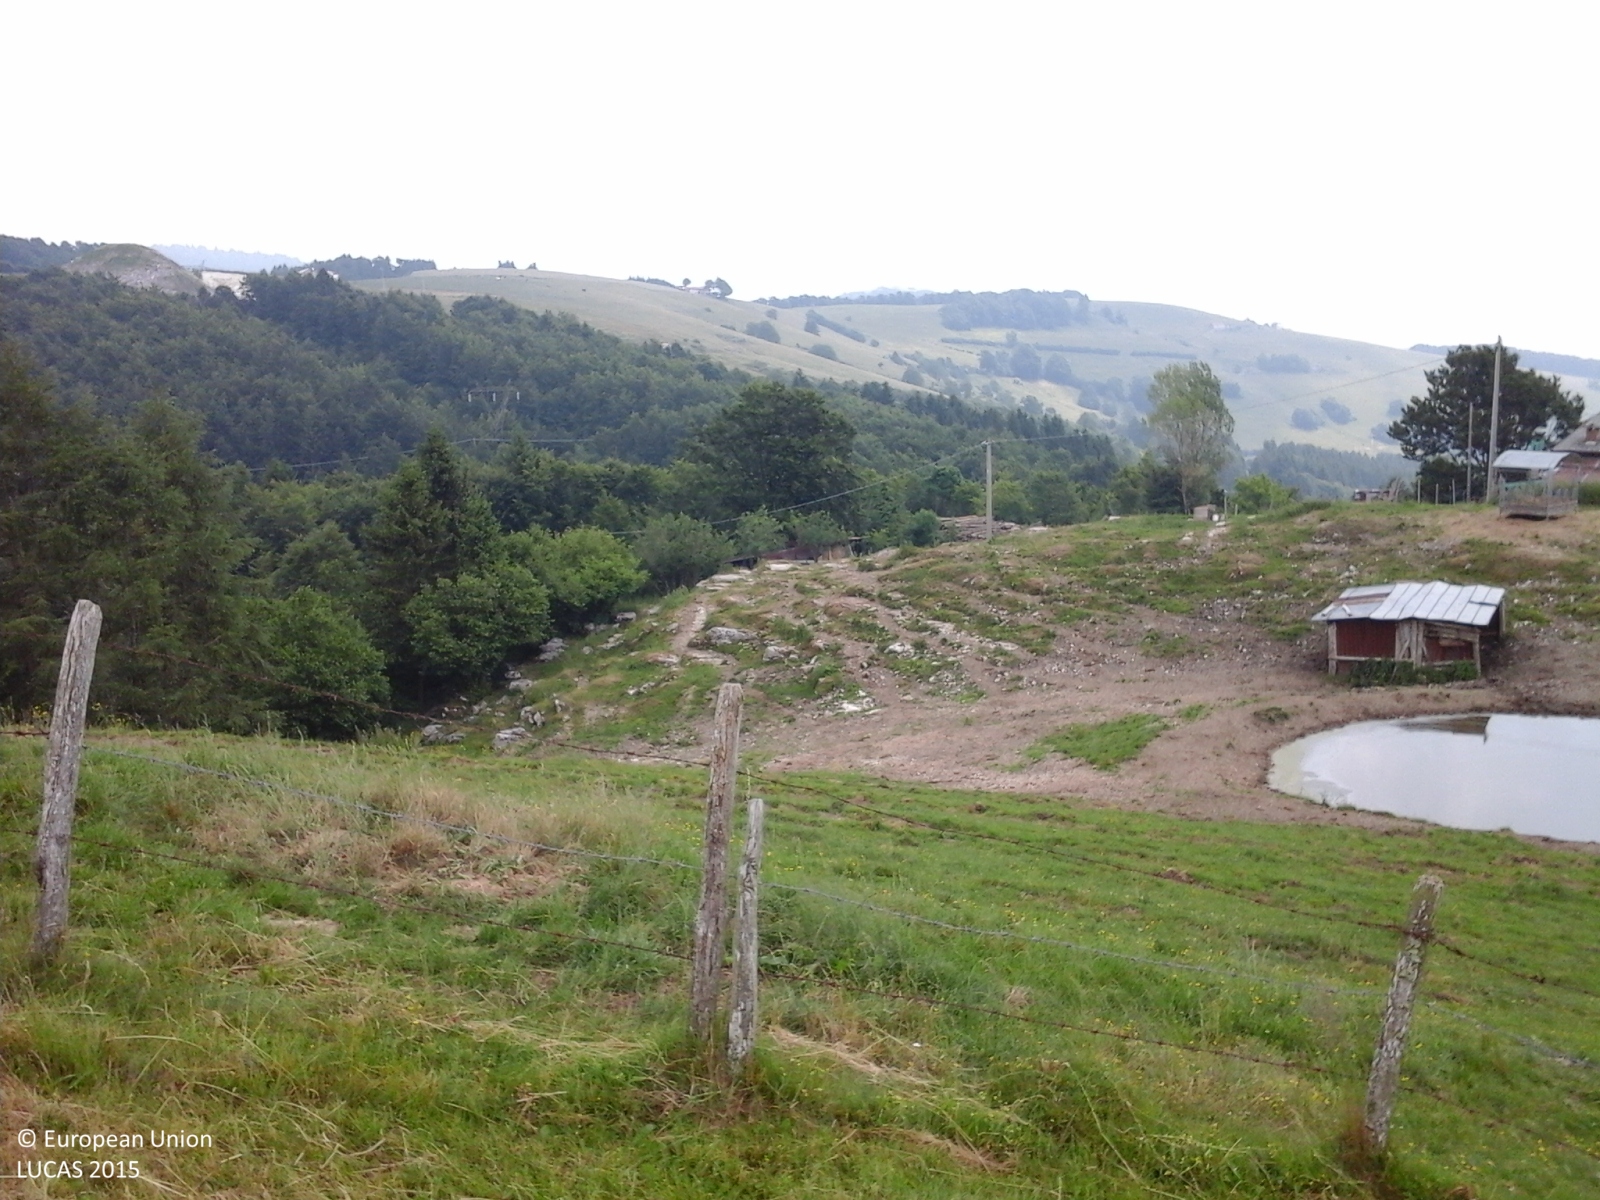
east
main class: Grassland
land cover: Grassland without tree/shrub cover
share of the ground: > 75 %
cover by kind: herbaceous plants 100 %
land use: Agriculture (excluding fallow land and kitchen gardens)
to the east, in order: Grassland without tree/shrub cover; Fences; Grassland without tree/shrub cover; Other mixed woodland; Electric lines; Other mixed woodland; Grassland without tree/shrub cover; Tracks; Grassland without tree/shrub cover; Fences; Broadleaved woodland; Shrubland with sparse tree cover; Electric lines; Paved roads, cycling and walking lanes; Fences; Grassland without tree/shrub cover
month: June
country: IT
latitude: 45.8166
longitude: 11.6064
